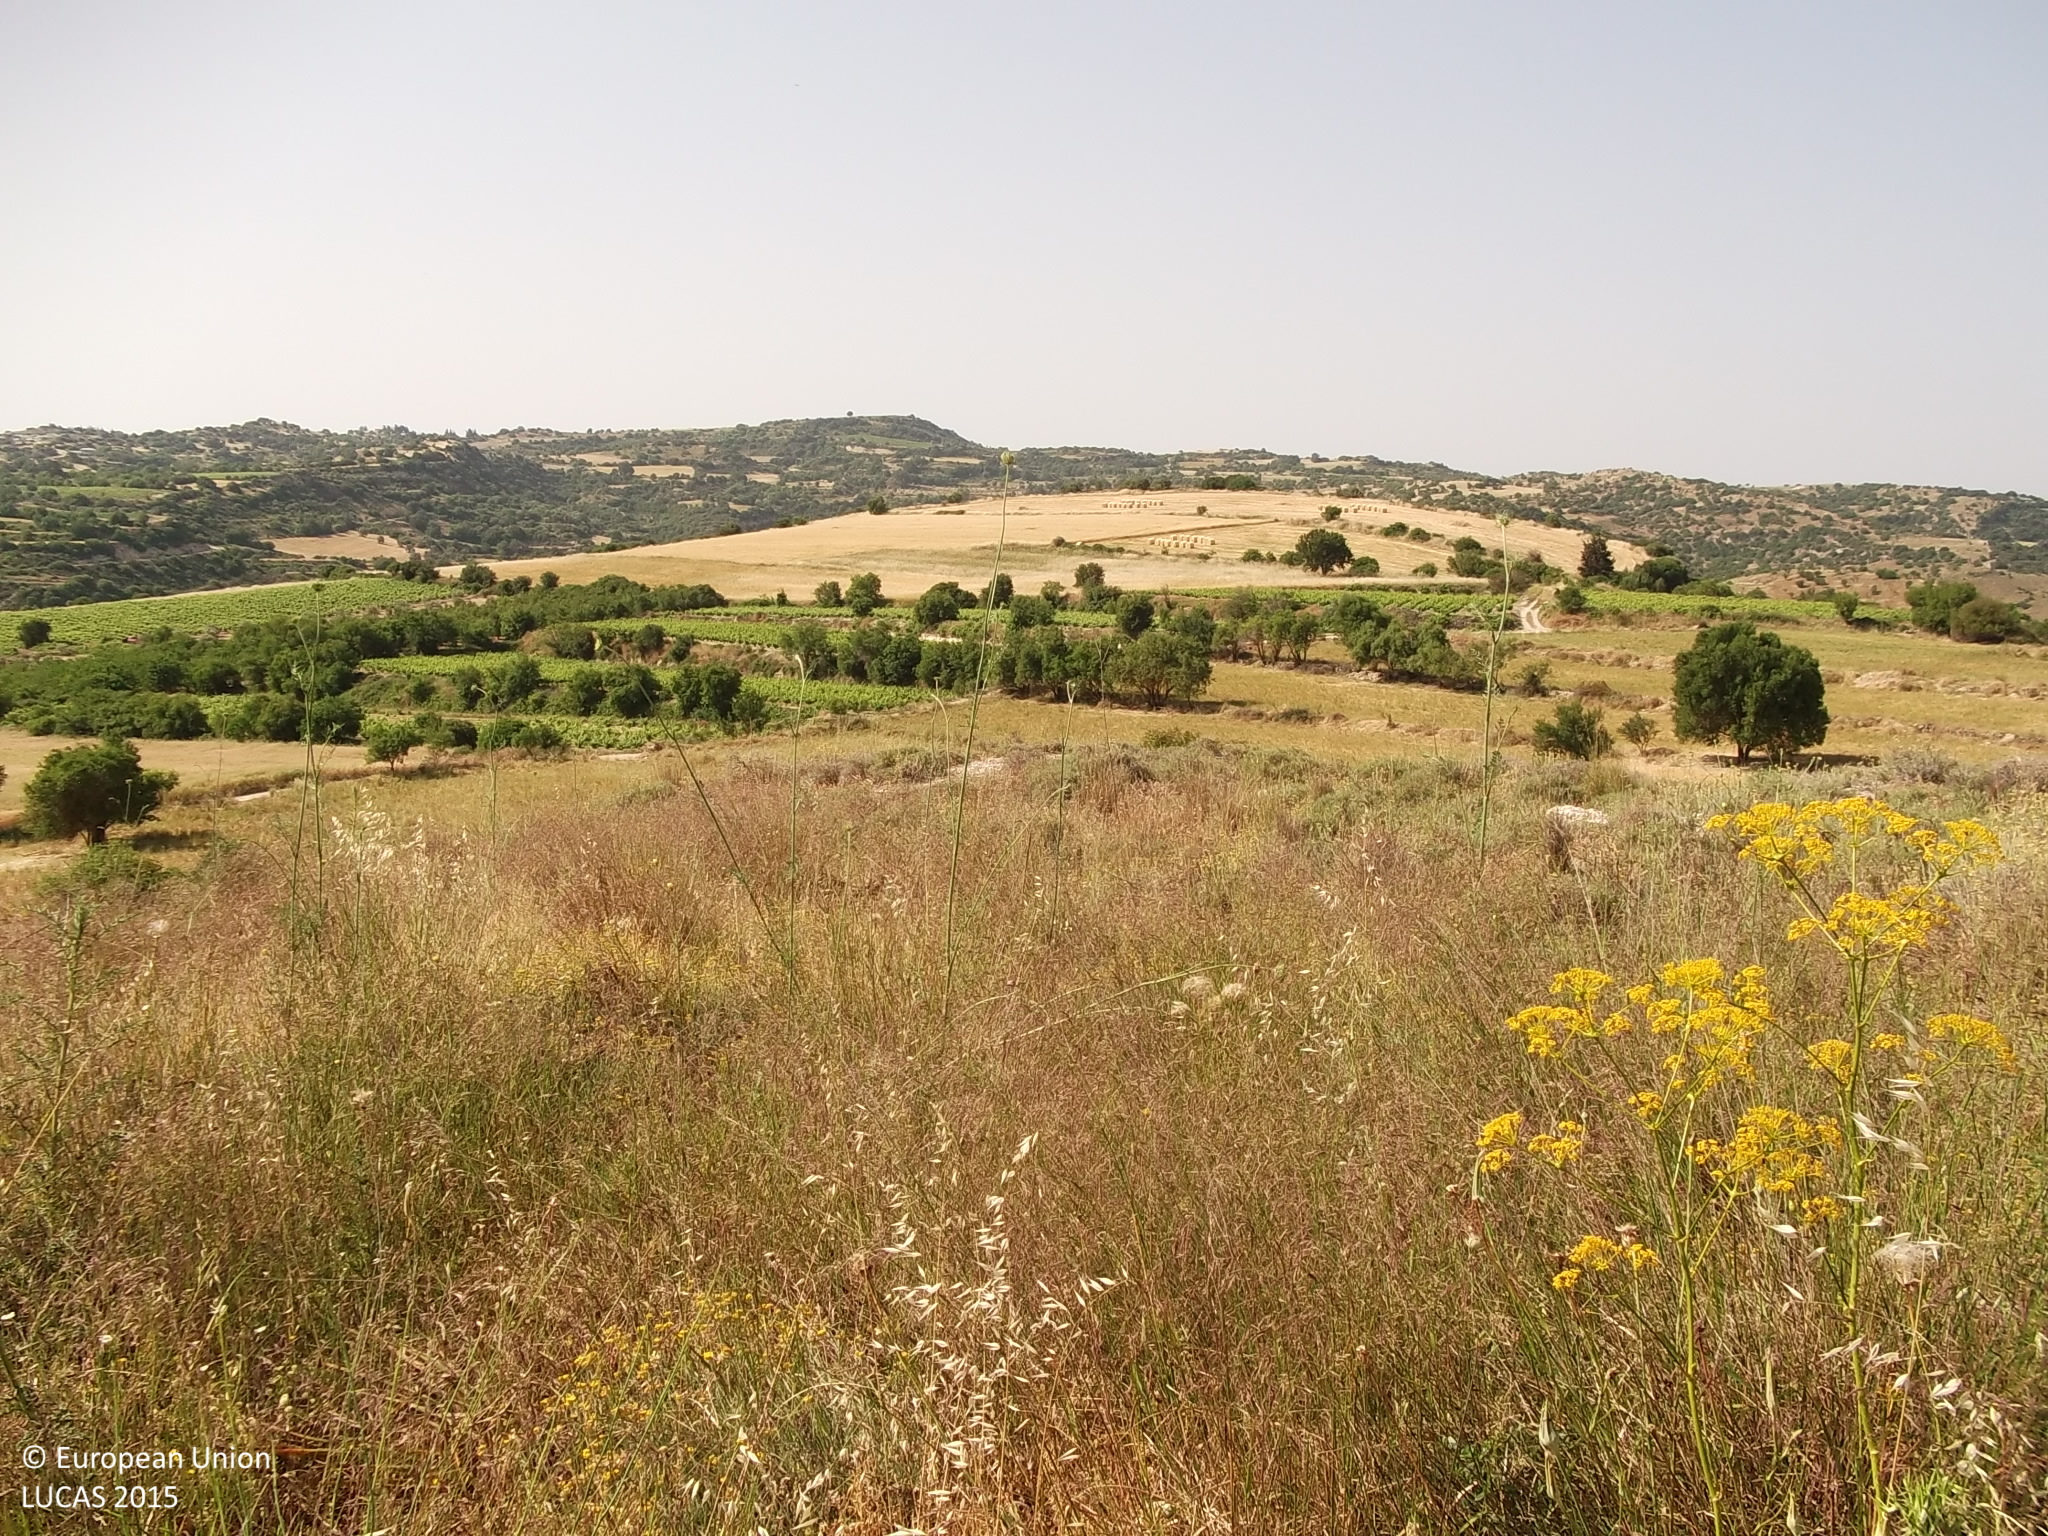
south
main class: Grassland
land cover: Grassland with sparse tree/shrub cover
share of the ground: > 75 %
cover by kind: herbaceous plants 95 %, broadleaved forest trees 5 %
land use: Semi-natural and natural areas not in use
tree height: < 5 m
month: May
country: CY
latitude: 34.8314
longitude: 32.5560
